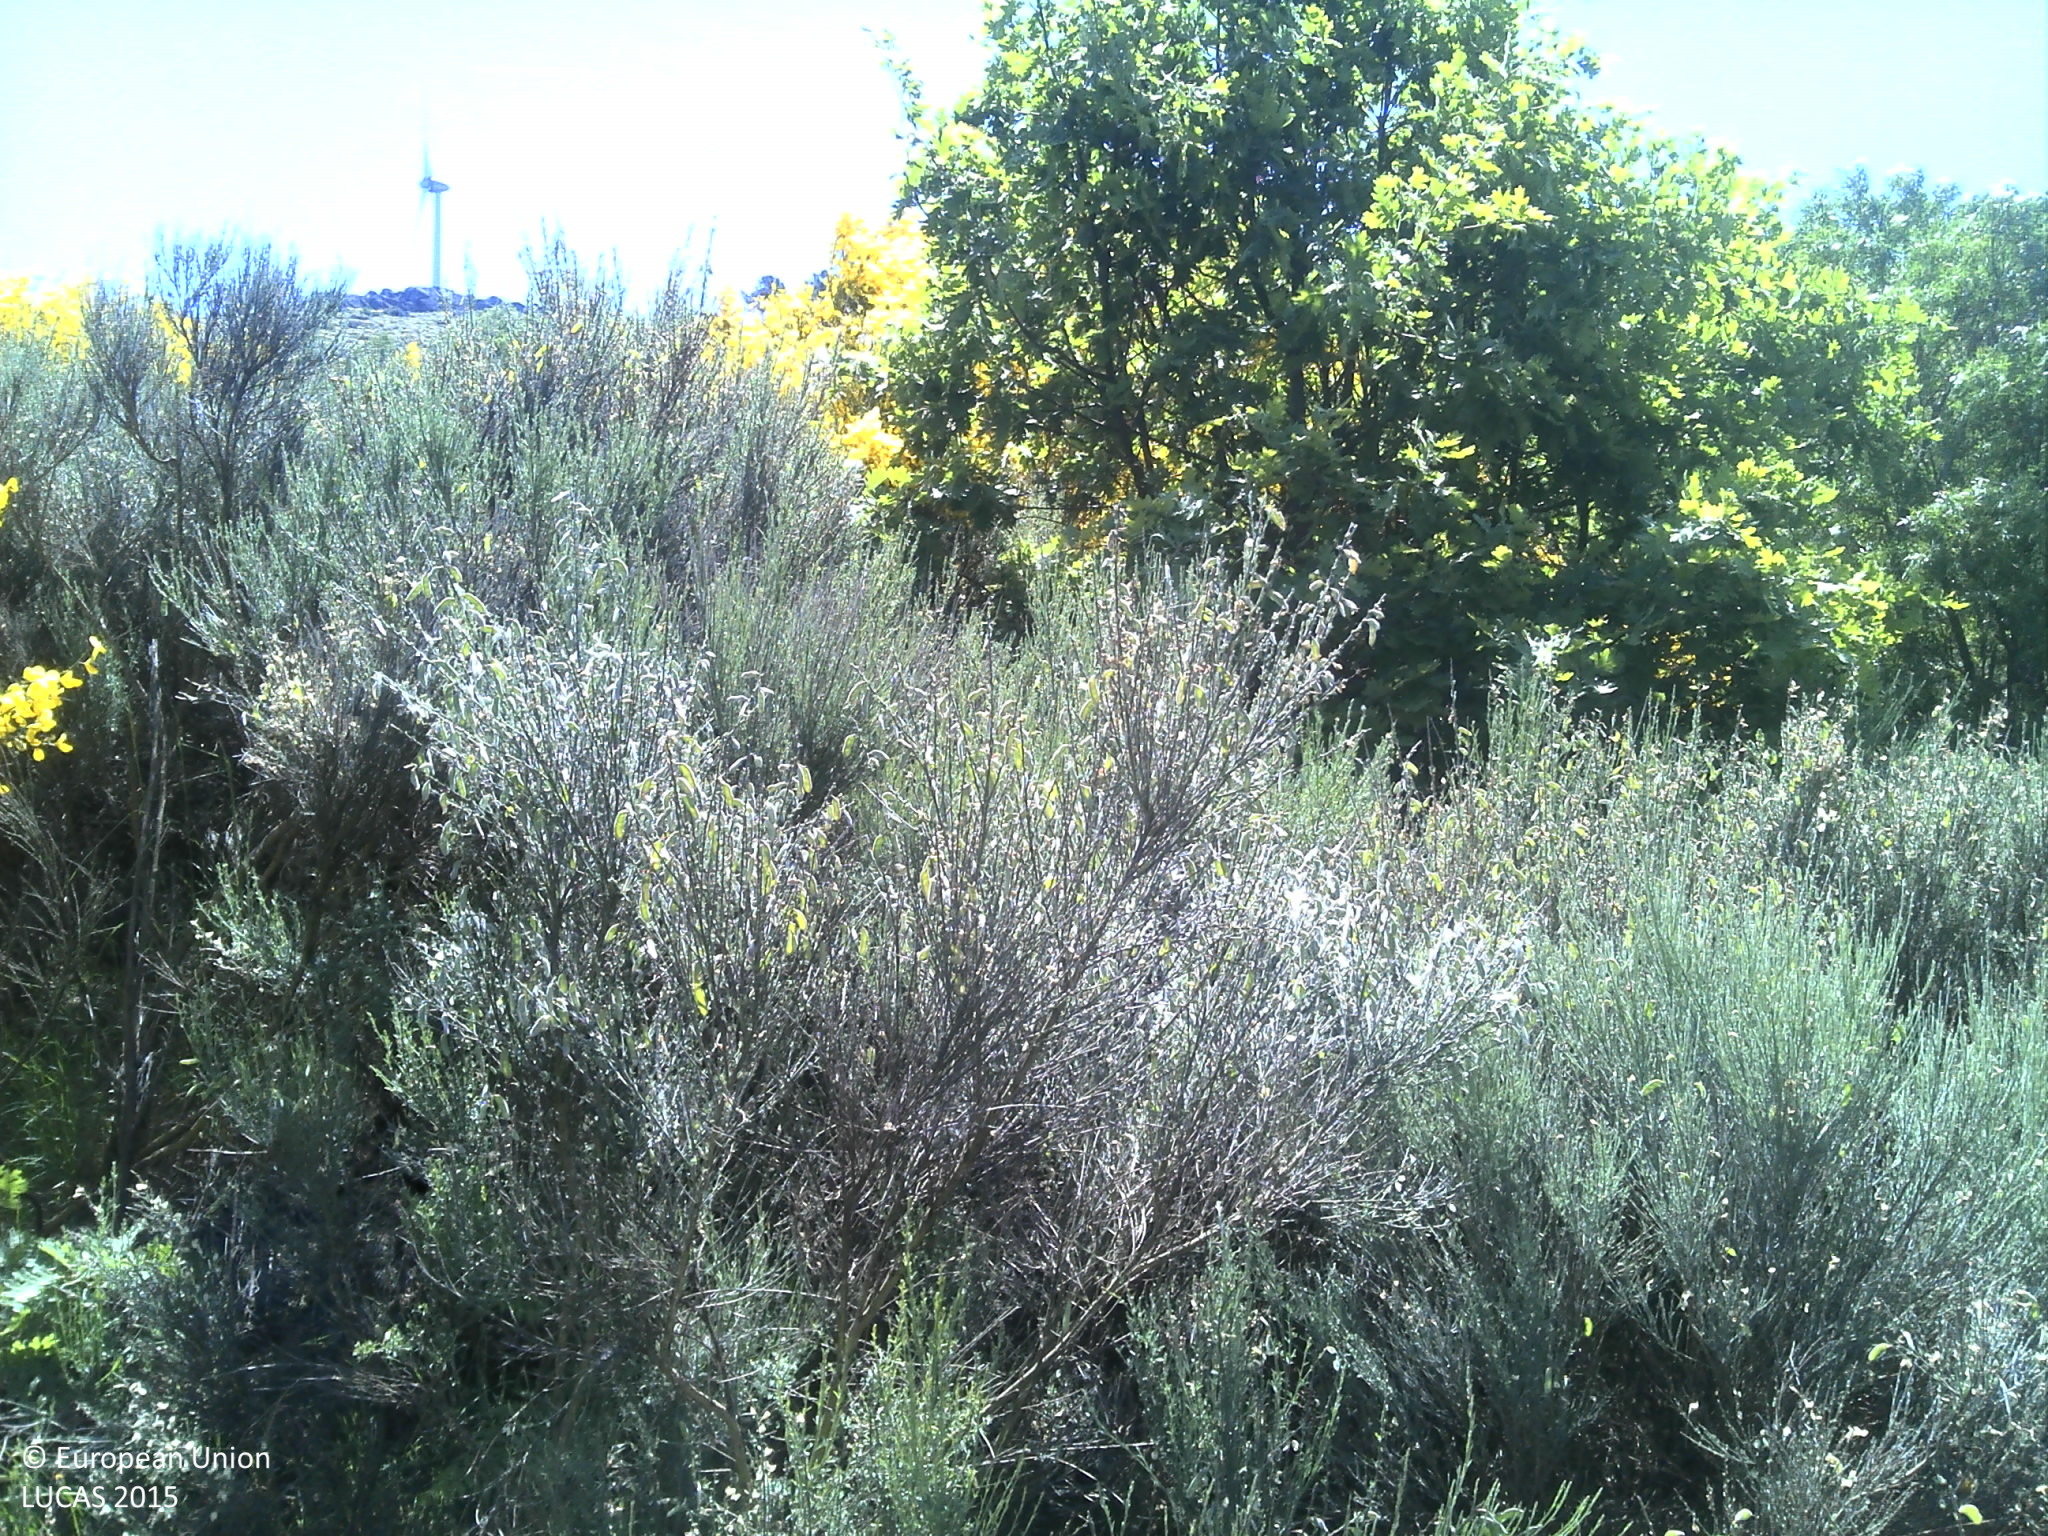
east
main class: Shrubland
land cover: Shrubland with sparse tree cover
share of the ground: > 75 %
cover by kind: shrubs 80 %, unconsolidated bare surface 10 %, broadleaved forest trees 5 %, herbaceous plants 5 %
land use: Semi-natural and natural areas not in use
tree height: > 5 m
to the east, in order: Shrubland with sparse tree cover; Shrubland without tree cover; Rock outcrops; Shrubland without tree cover
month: May
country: PT
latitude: 40.4592
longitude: -7.3594
